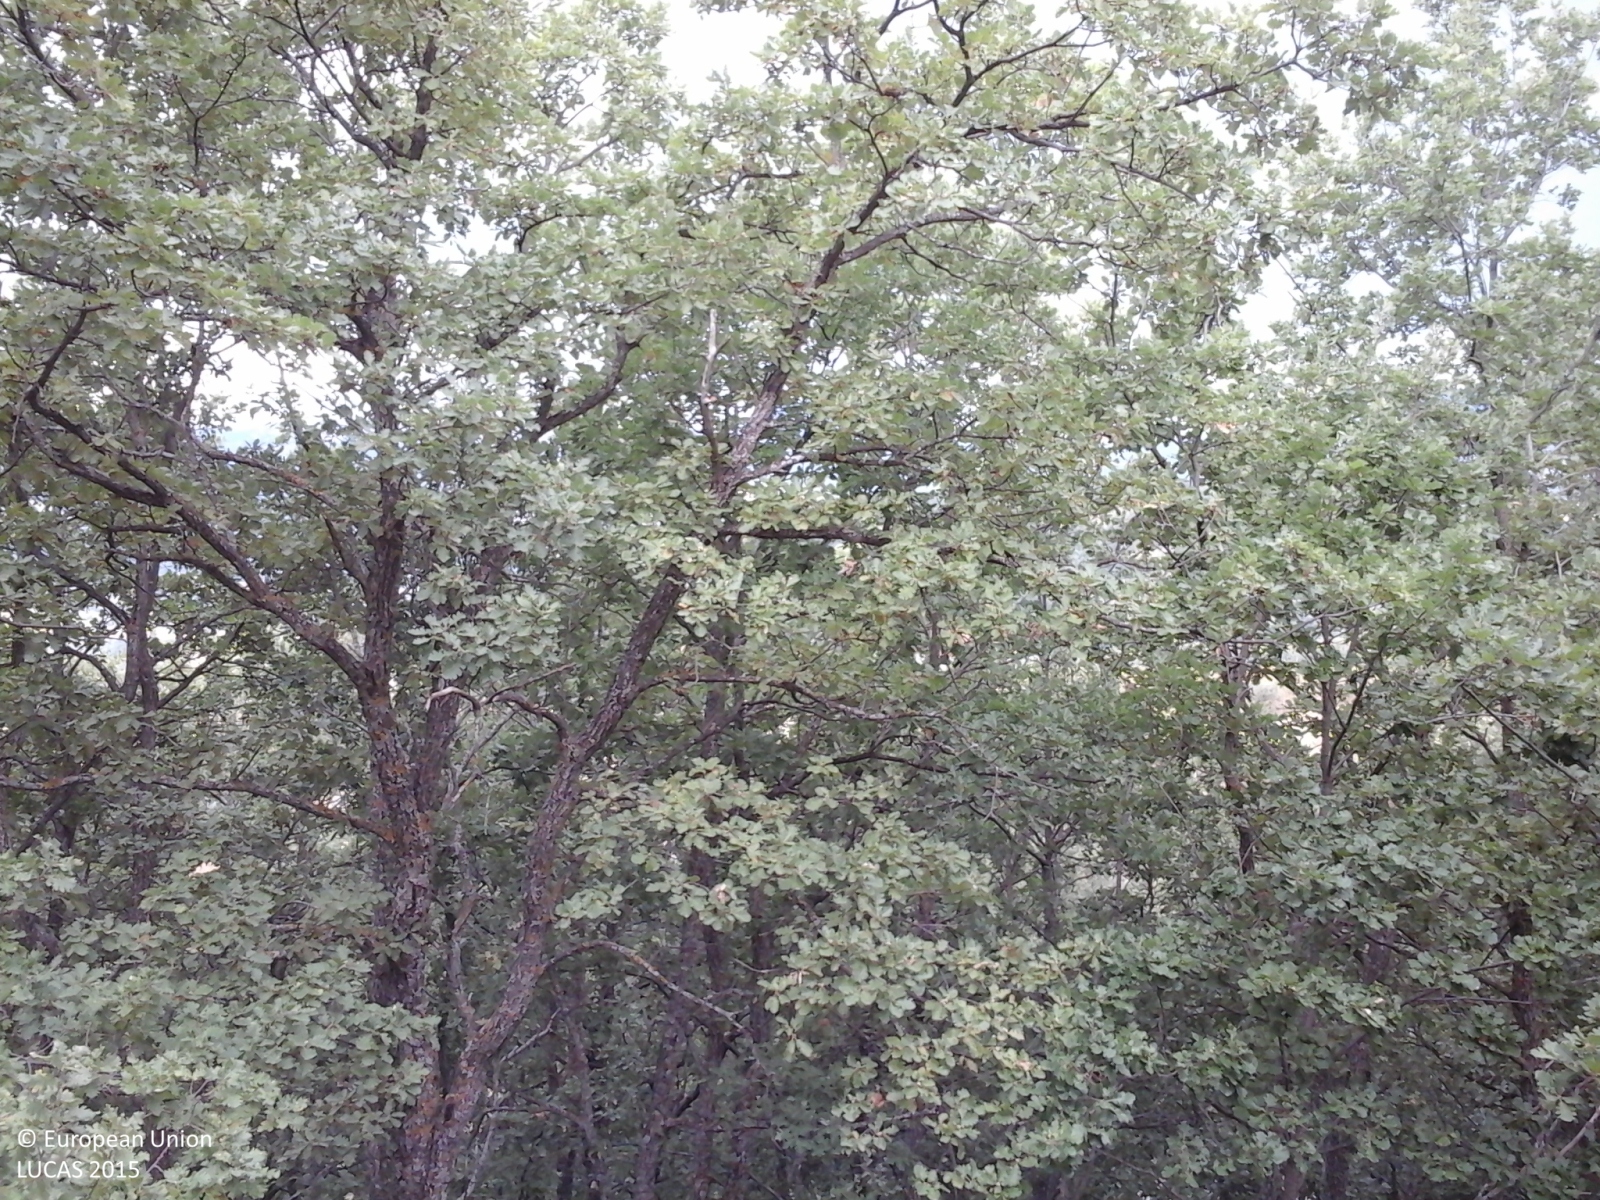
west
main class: Woodland
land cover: Broadleaved woodland
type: thermophilous deciduous forest
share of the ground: > 75 %
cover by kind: broadleaved forest trees 75 %, shrubs 20 %, herbaceous plants 5 %
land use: Semi-natural and natural areas not in use
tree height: > 5 m
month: August
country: IT
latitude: 41.7985
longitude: 14.4019
